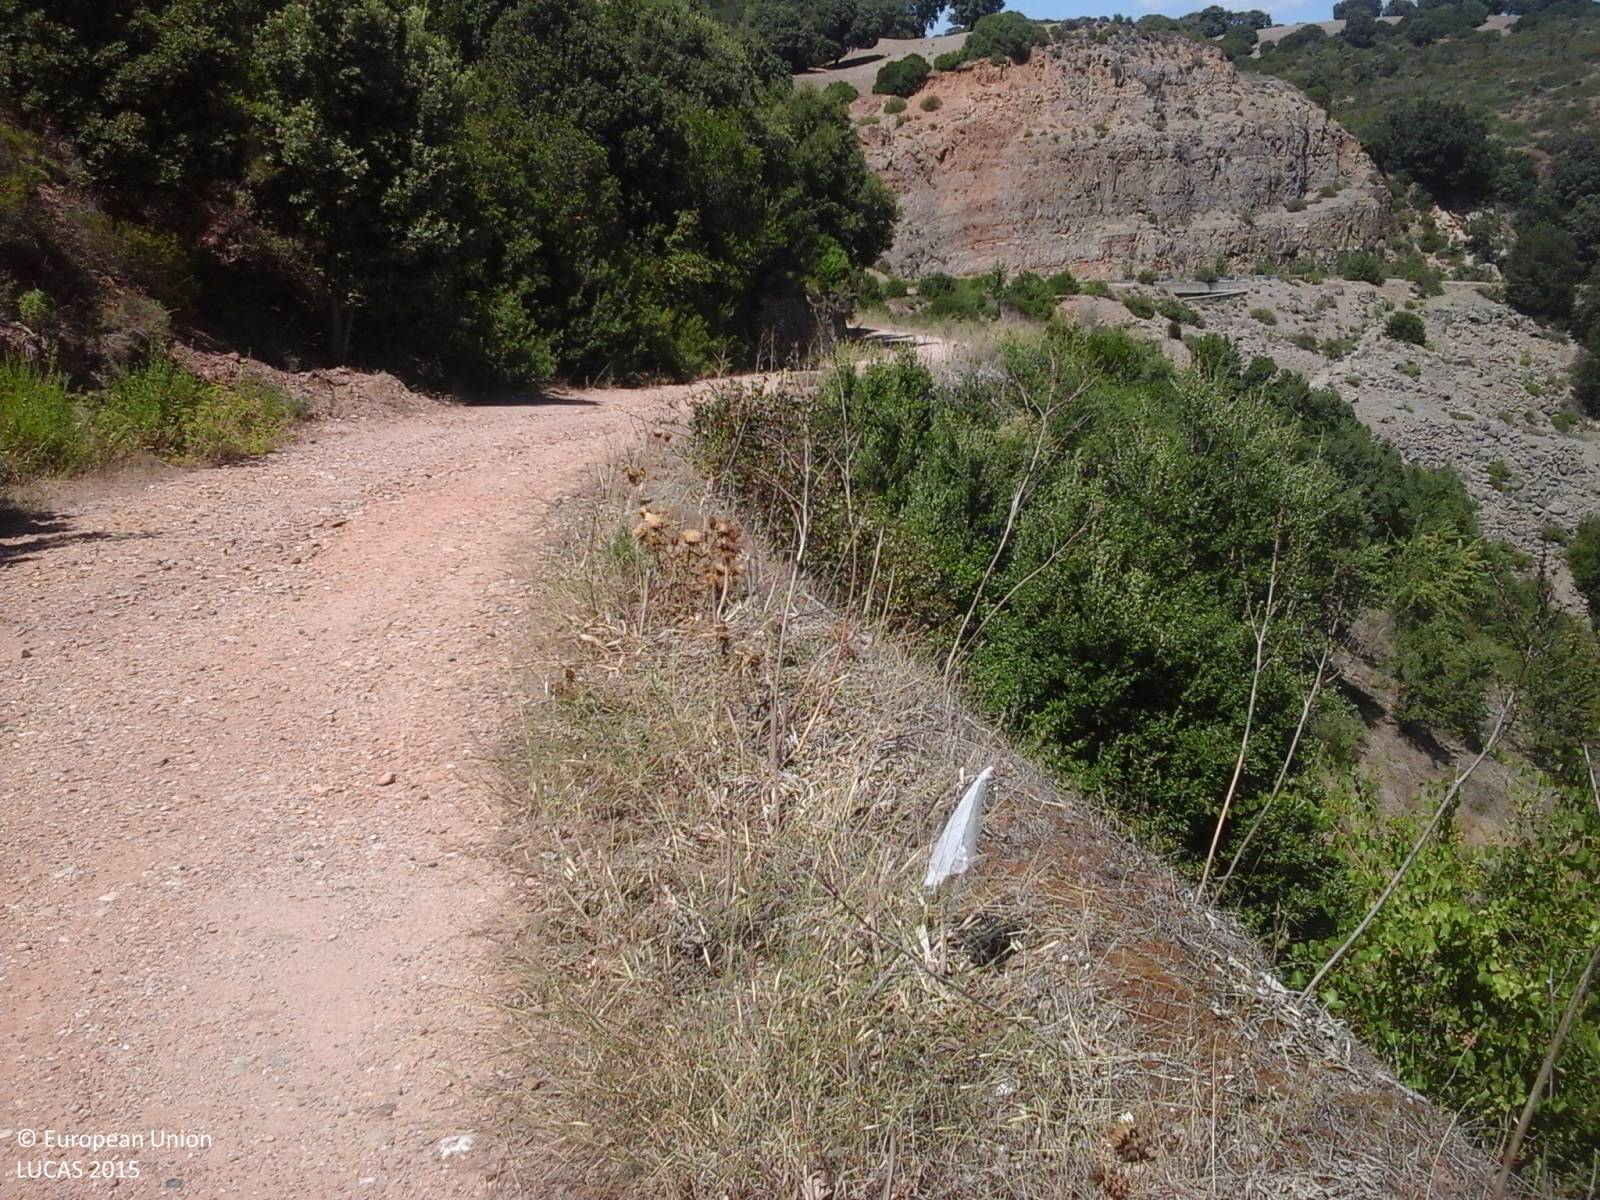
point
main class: Shrubland
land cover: Shrubland without tree cover
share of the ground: > 75 %
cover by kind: shrubs 100 %
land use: Semi-natural and natural areas not in use
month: August
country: IT
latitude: 39.6496
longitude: 9.3627
